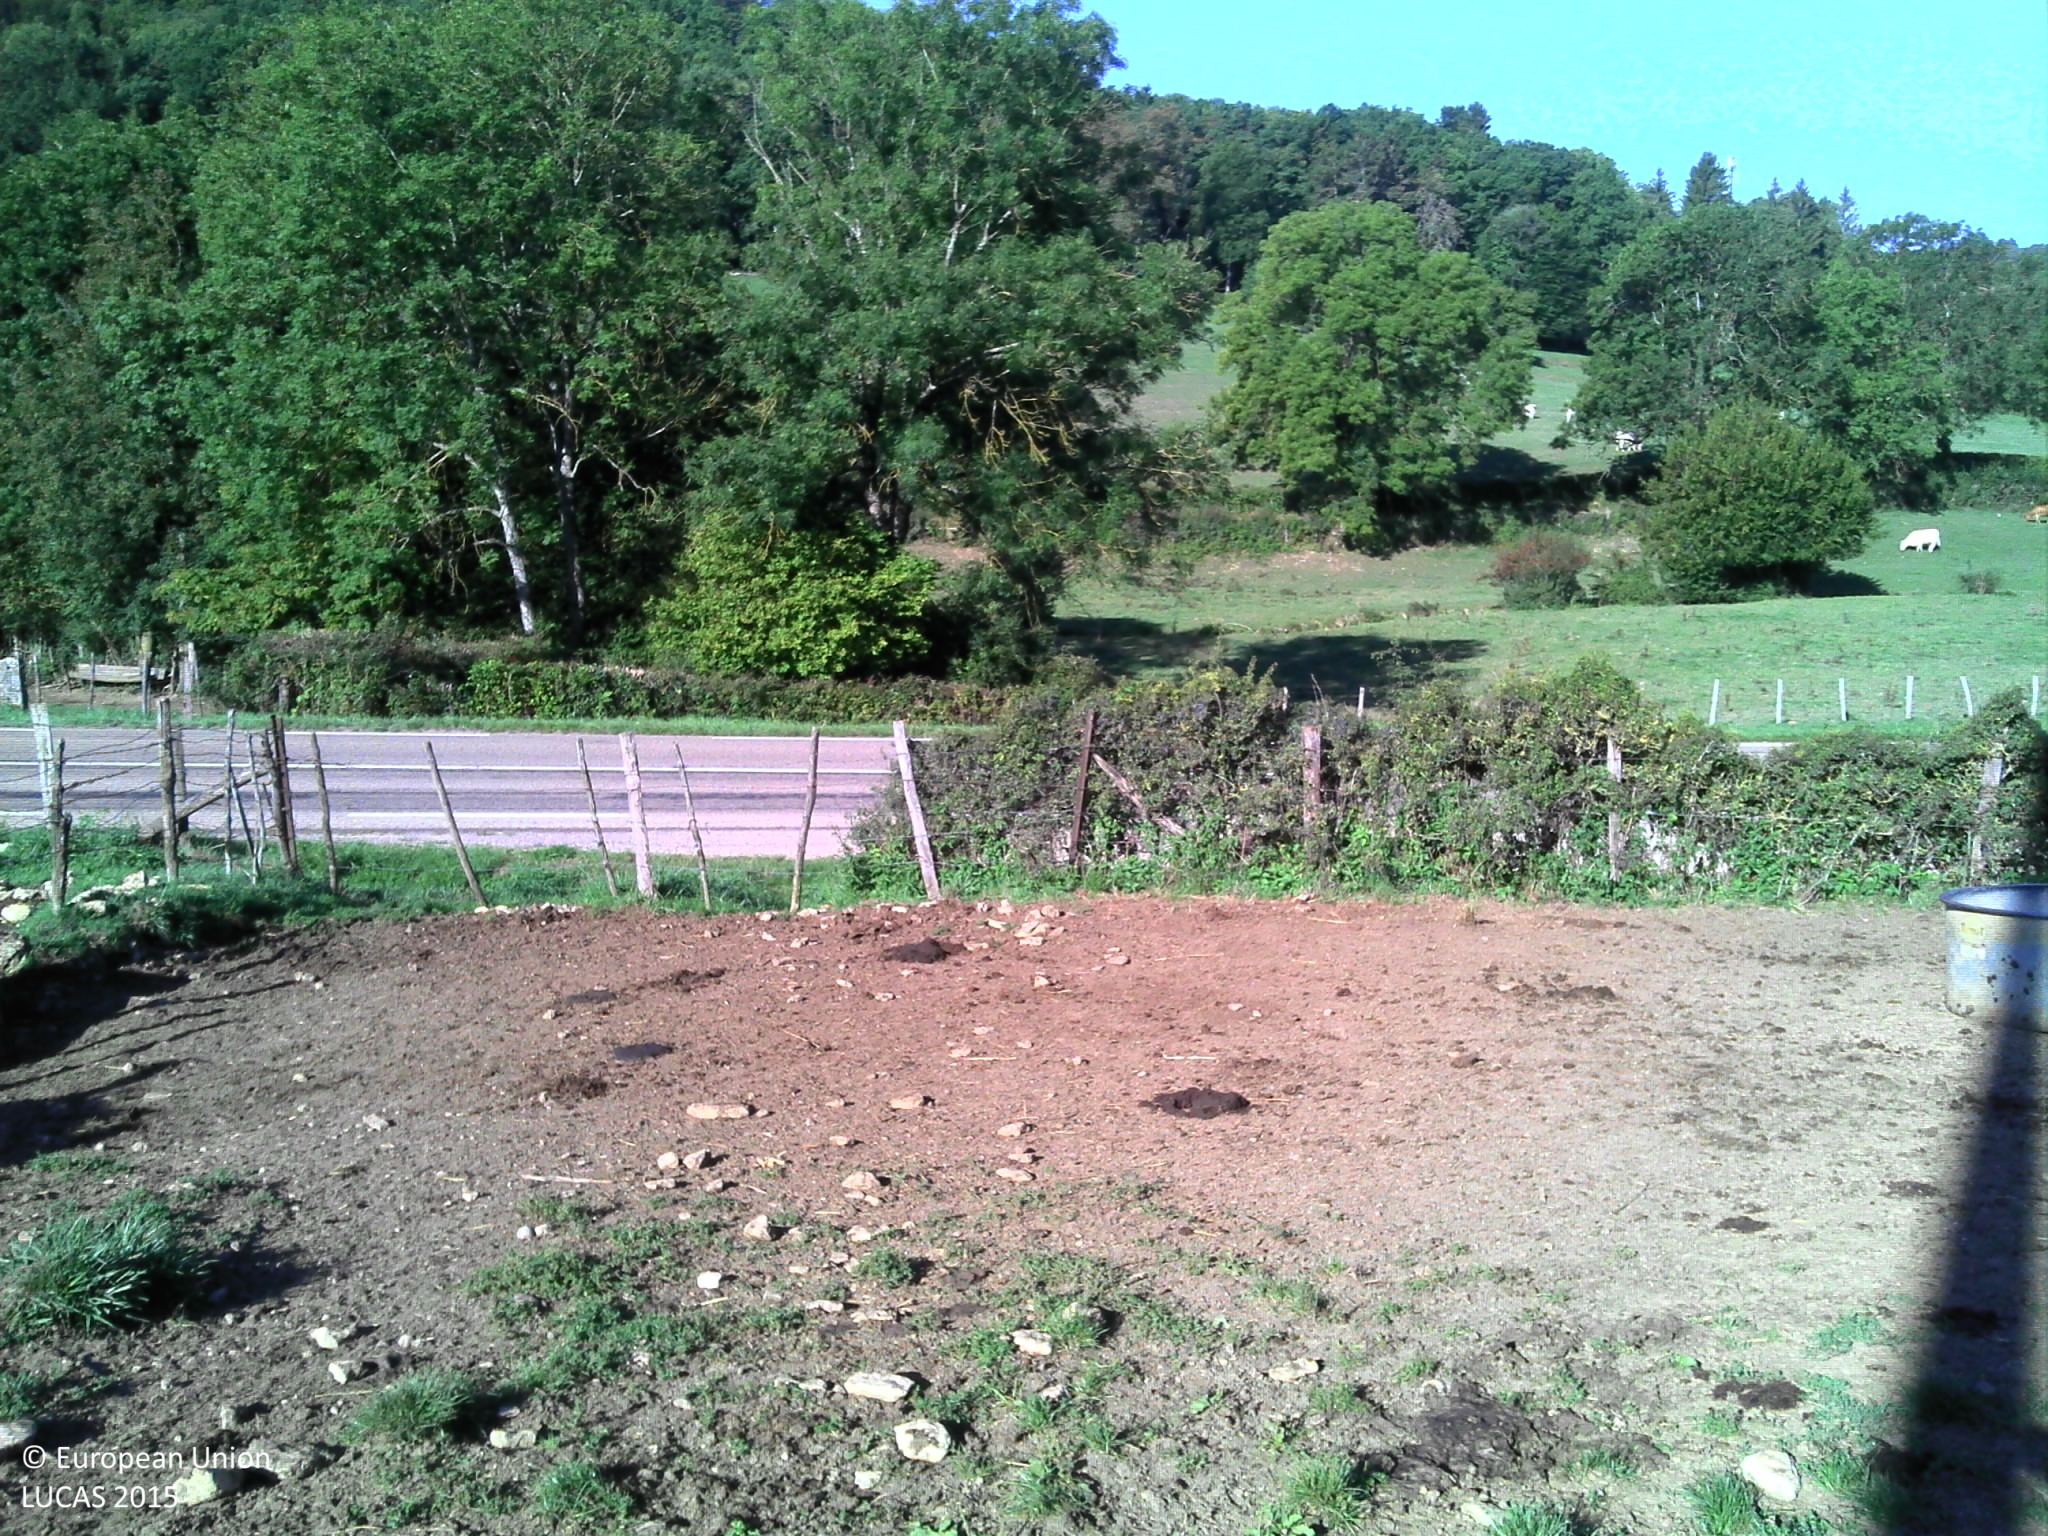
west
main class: Grassland
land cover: Grassland without tree/shrub cover
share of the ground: > 75 %
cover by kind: herbaceous plants 90 %, unconsolidated bare surface 10 %
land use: Agriculture (excluding fallow land and kitchen gardens)
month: September
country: FR
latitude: 47.6080
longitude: 4.3183
